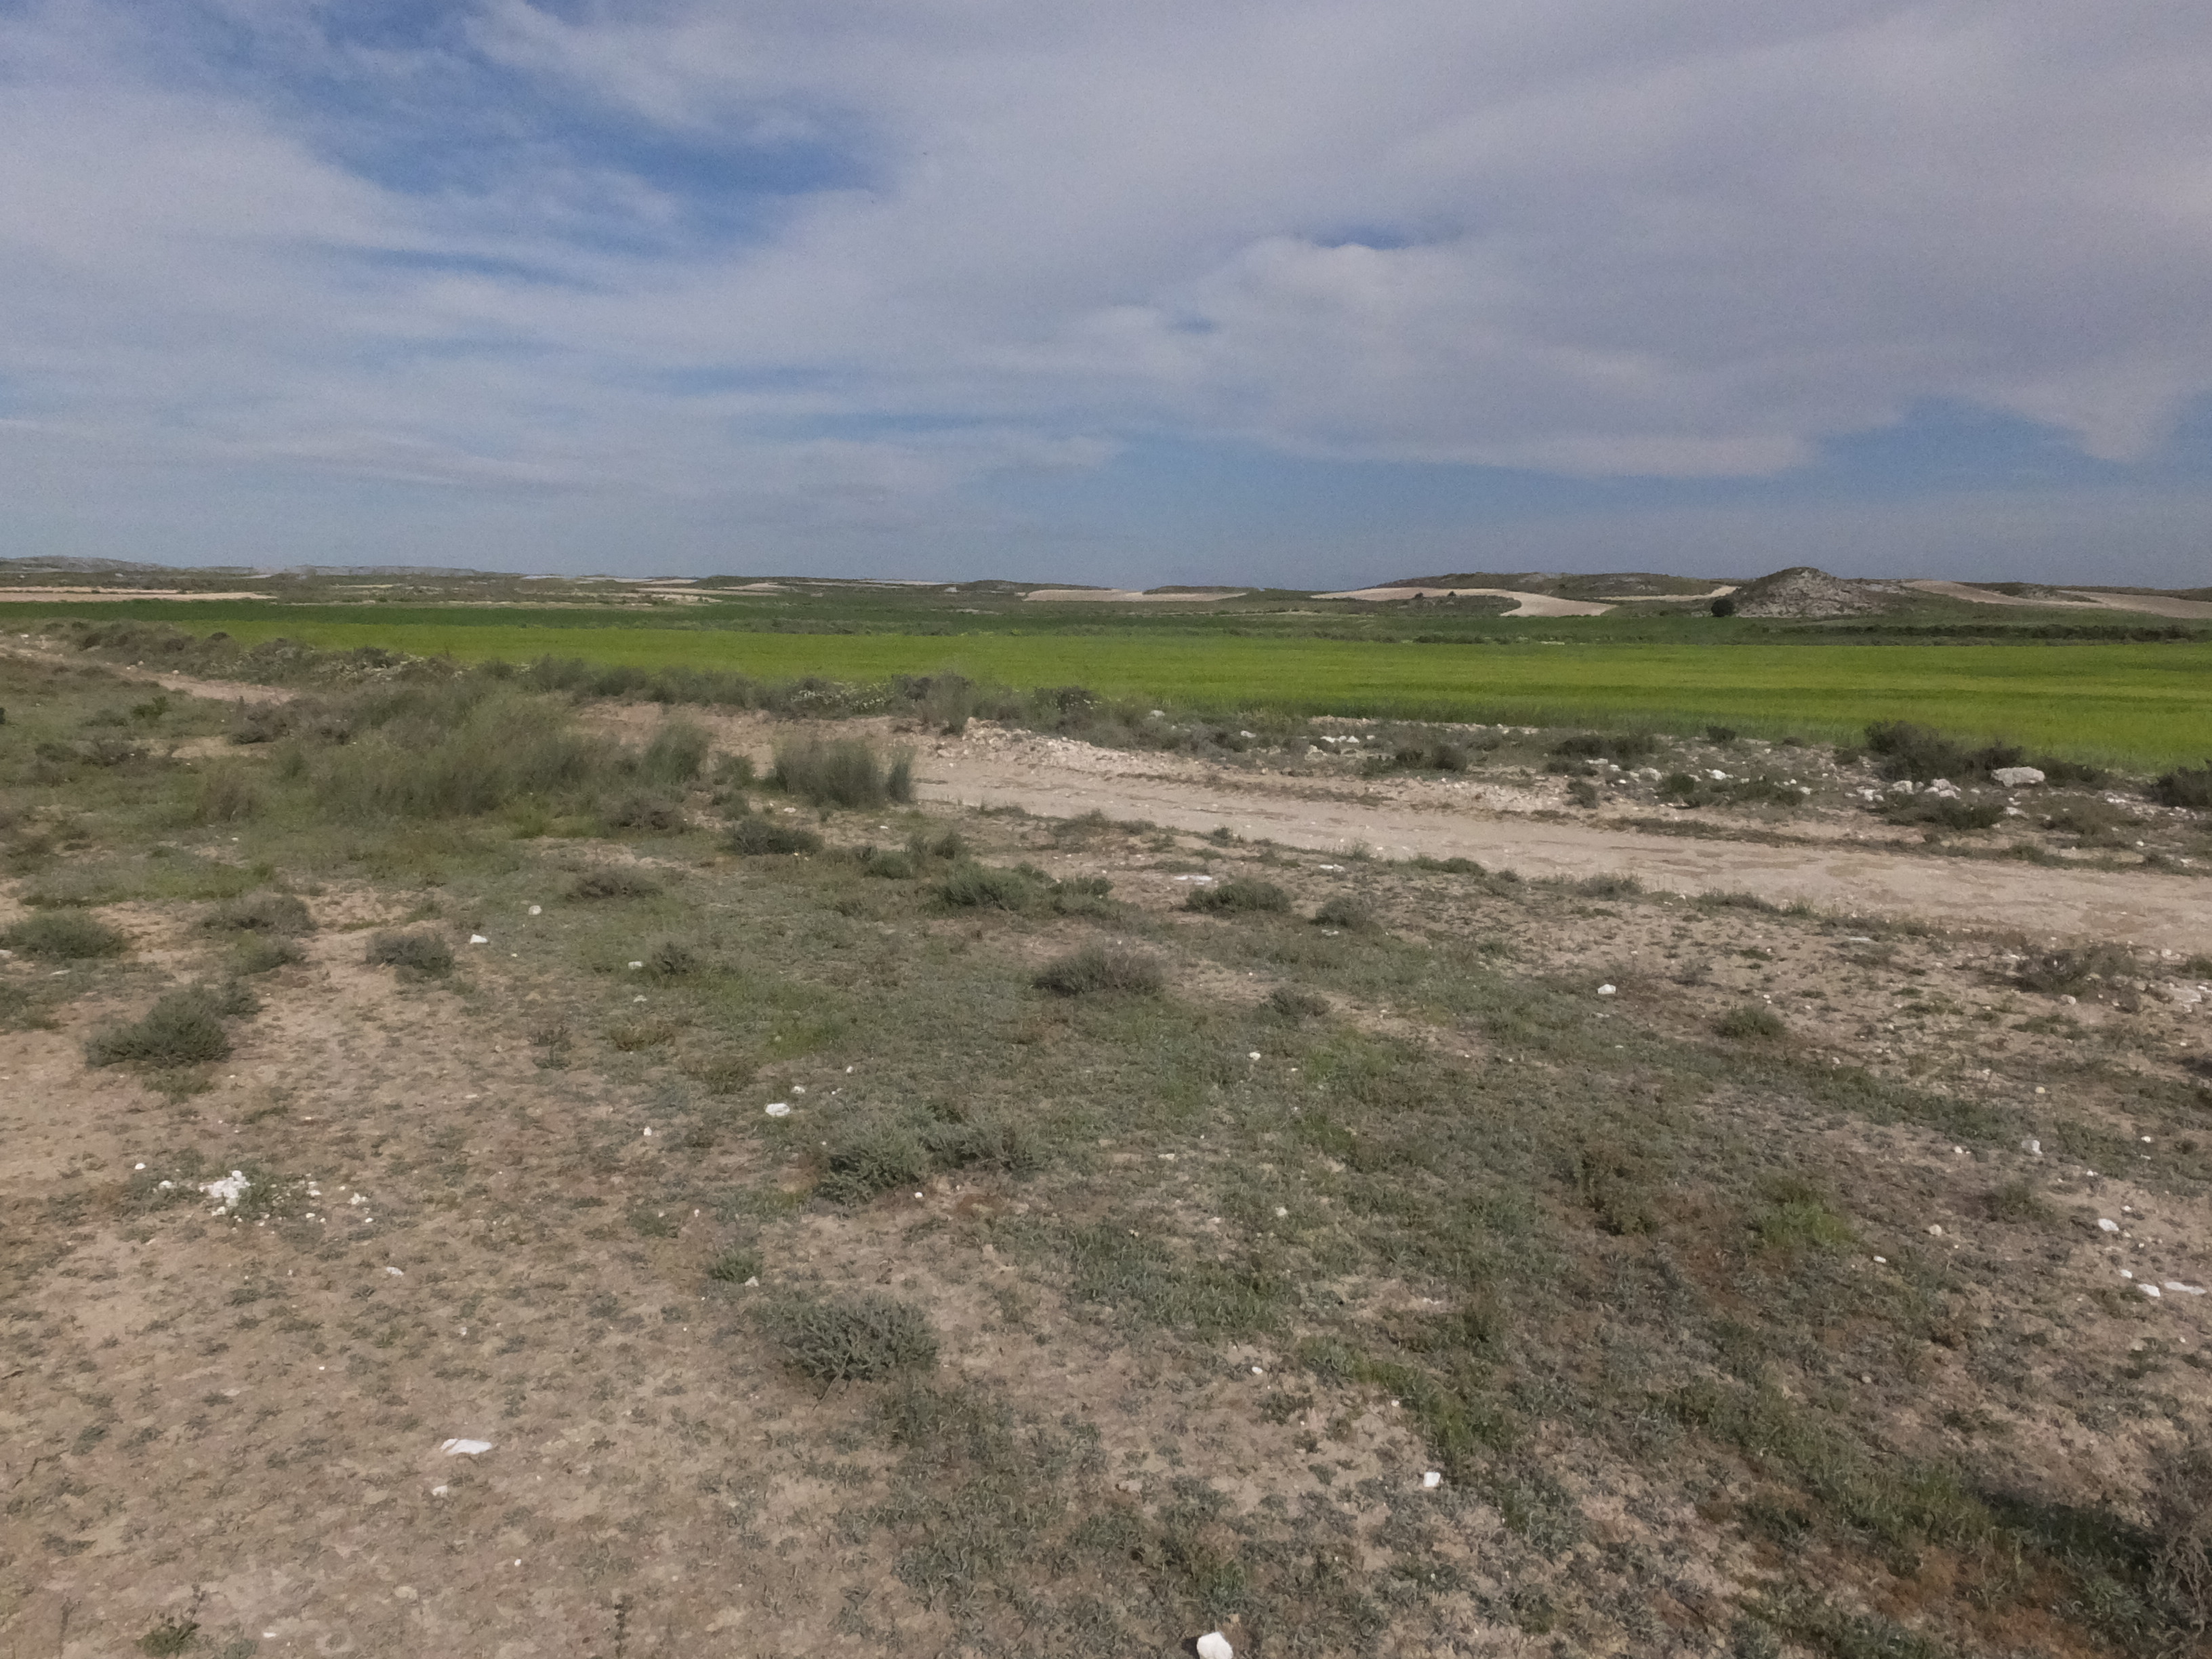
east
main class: Grassland
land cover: Grassland without tree/shrub cover
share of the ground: 50 - 75 %
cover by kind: herbaceous plants 75 %, unconsolidated bare surface 25 %
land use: Semi-natural and natural areas not in use
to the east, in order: Grassland without tree/shrub cover; Tracks; Shruby margins; Barley; Shruby margins; Durum wheat; Shruby margins; Durum wheat
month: April
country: ES
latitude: 41.5567
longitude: -0.3646
